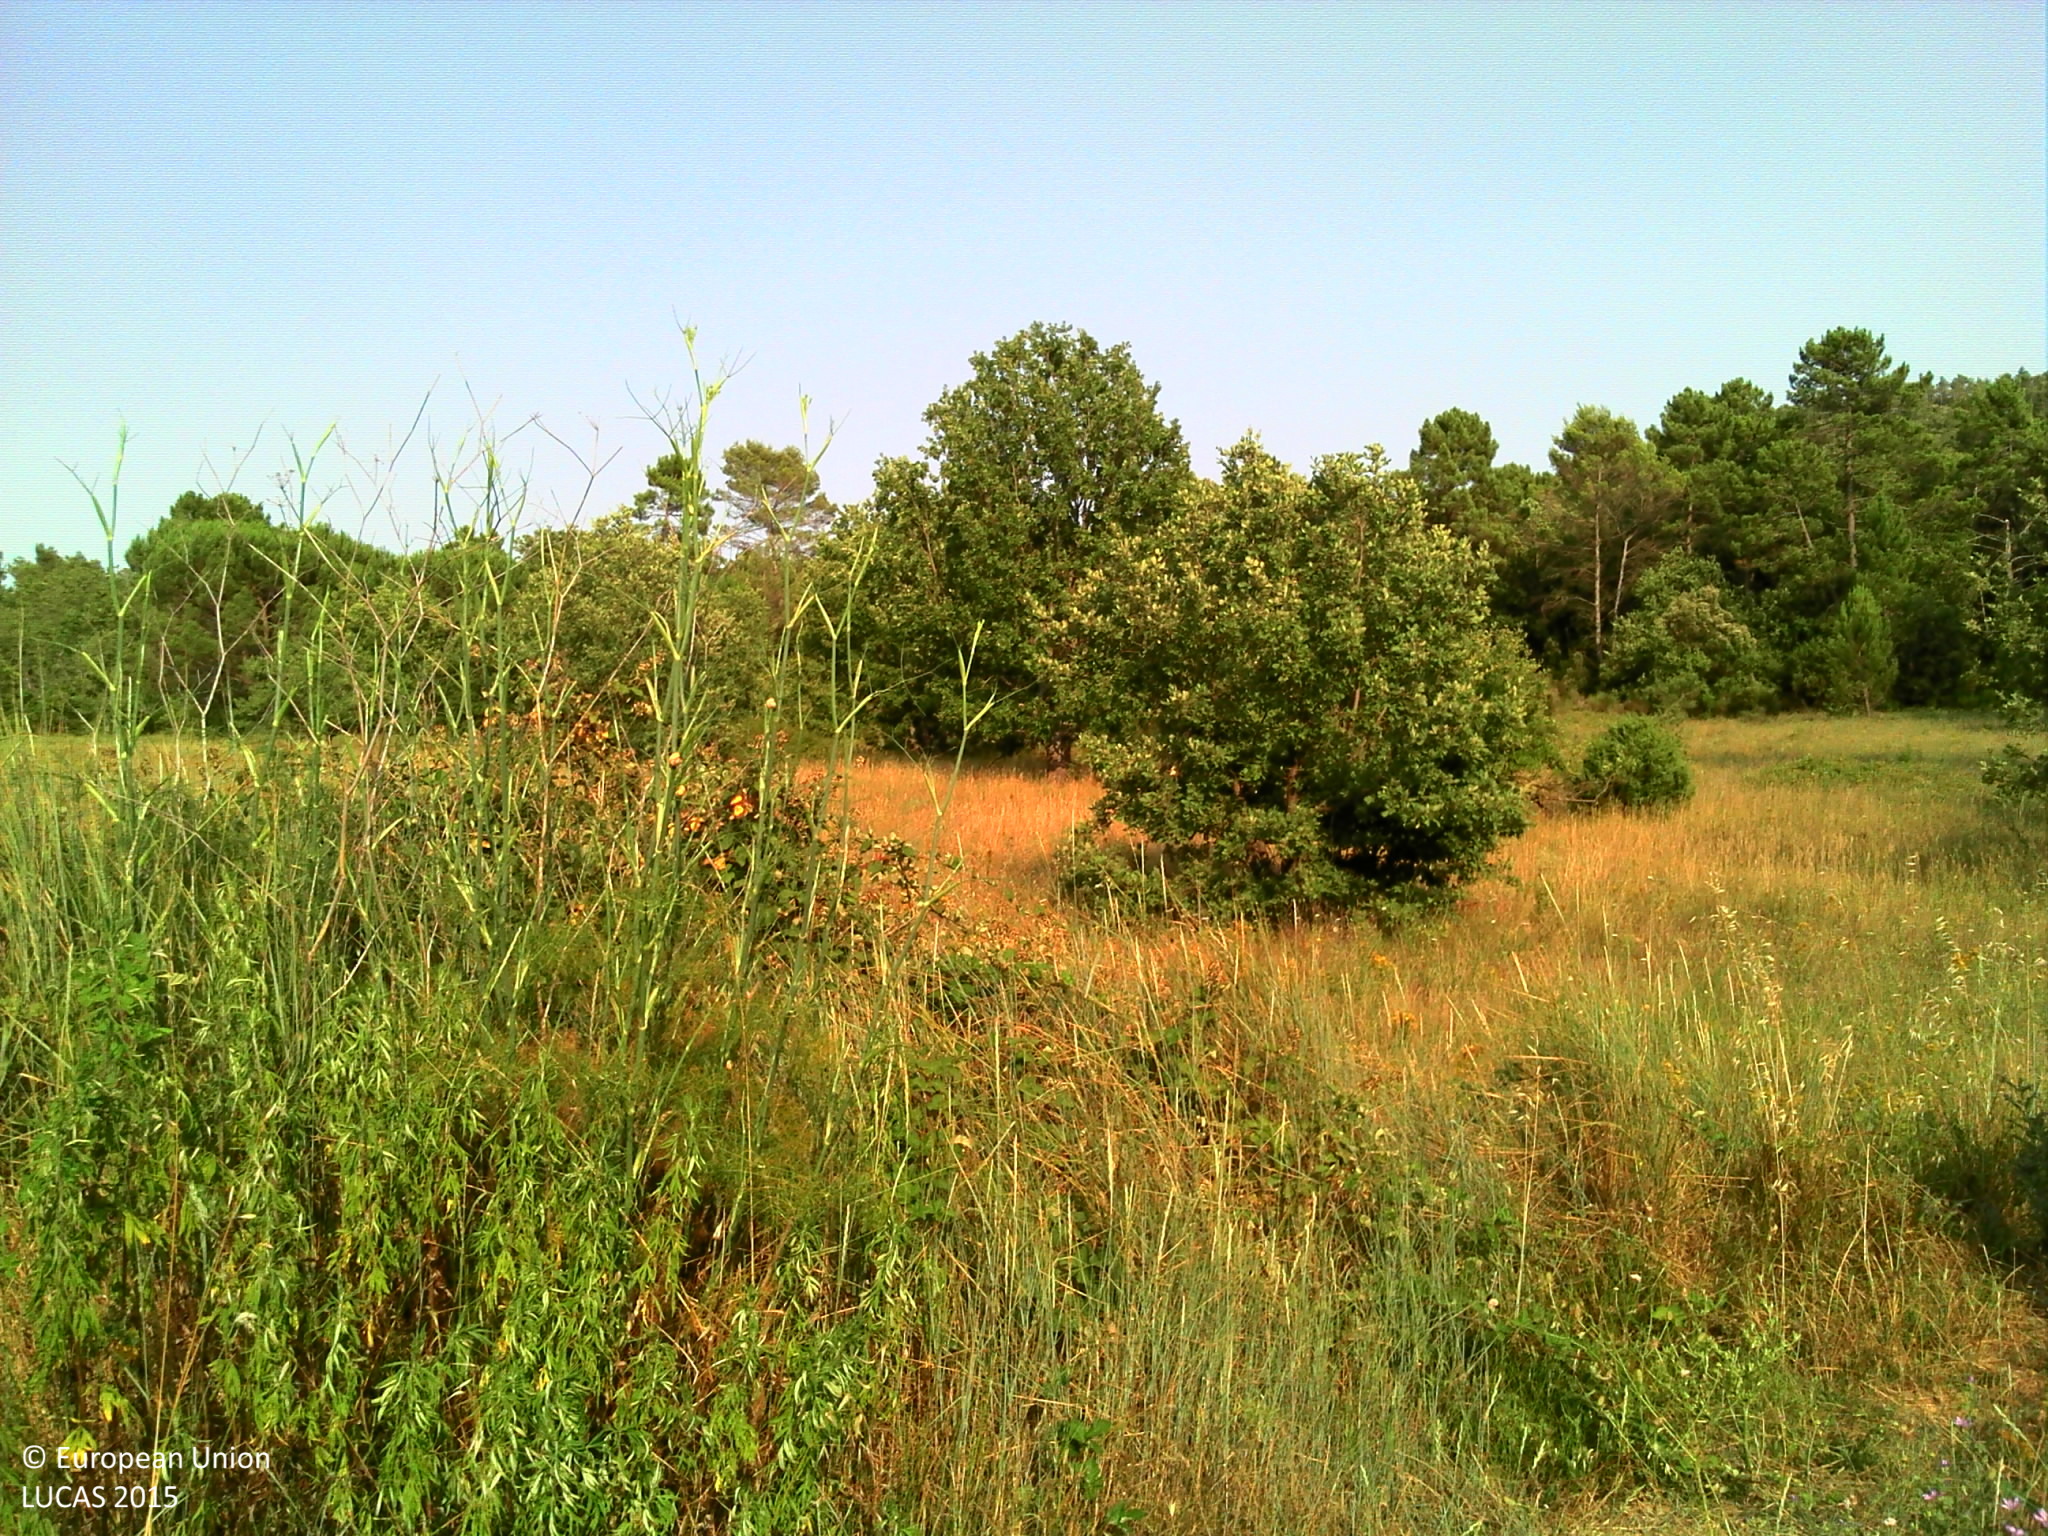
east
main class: Woodland
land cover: Pine dominated mixed woodland
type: coniferous forest of the mediterranean region
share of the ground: > 75 %
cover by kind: coniferous forest trees 70 %, broadleaved forest trees 25 %, shrubs 5 %
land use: Semi-natural and natural areas not in use
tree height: > 5 m
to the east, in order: Pine dominated mixed woodland; Tracks; Pine dominated mixed woodland
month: July
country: FR
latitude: 43.3784
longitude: 5.7516
